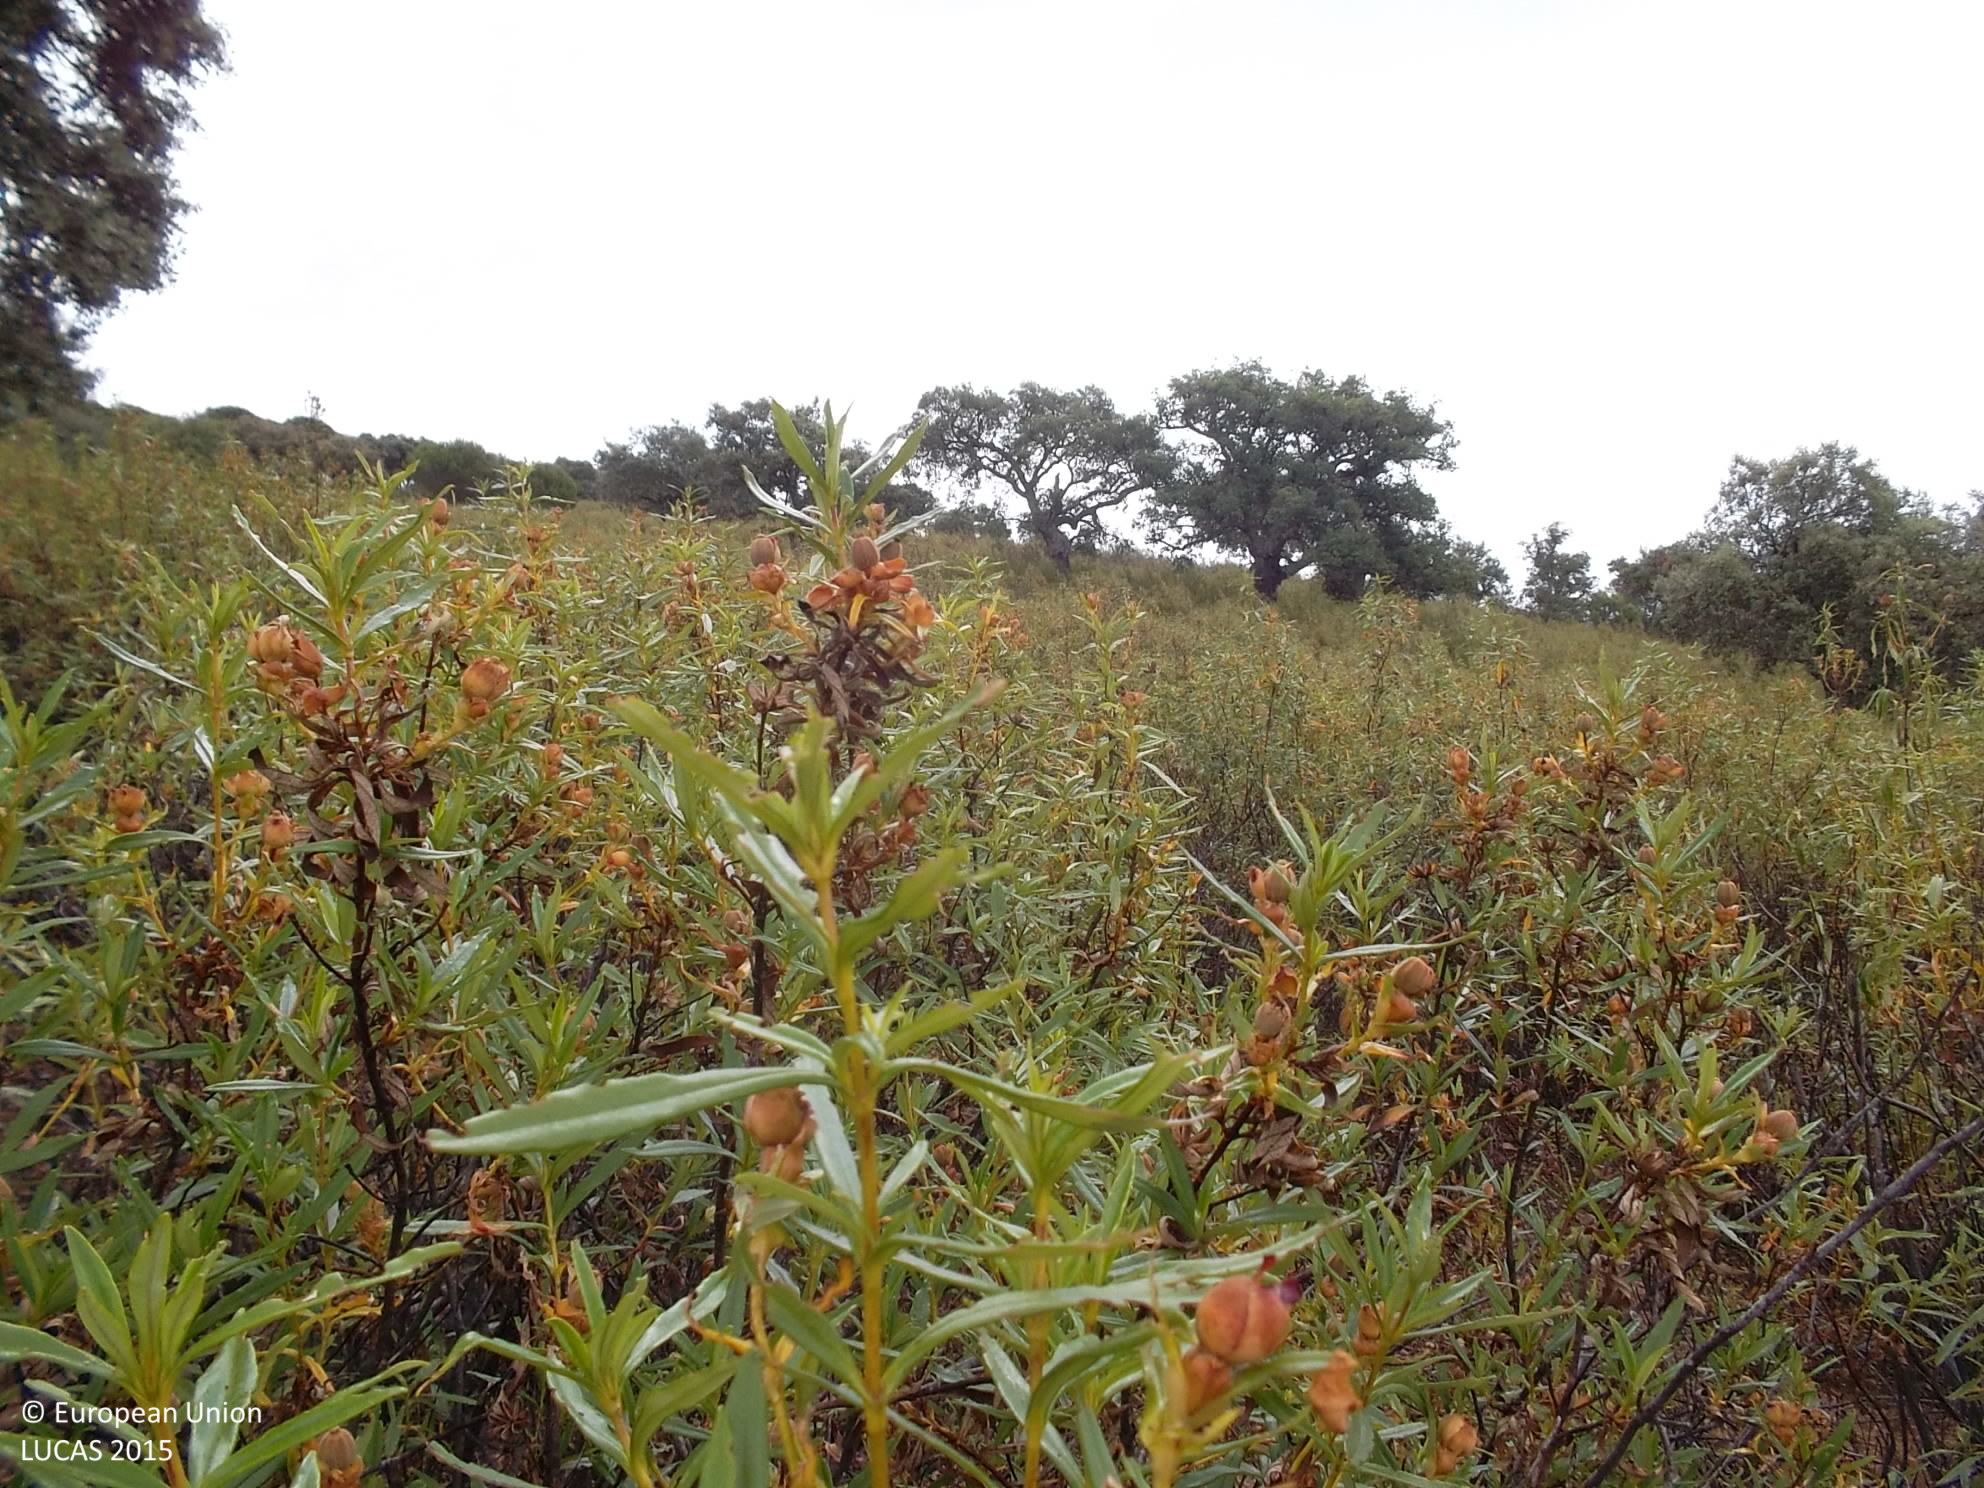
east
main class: Woodland
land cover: Broadleaved woodland
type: broadleaved evergreen forest
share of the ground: 50 - 75 %
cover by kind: shrubs 70 %, broadleaved forest trees 20 %, herbaceous plants 10 %
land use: Semi-natural and natural areas not in use
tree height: > 5 m
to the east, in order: Broadleaved woodland; Shrubland with sparse tree cover; Pine dominated mixed woodland; Tracks; Other structural elements; Pine dominated mixed woodland; Shrubland with sparse tree cover
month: June
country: ES
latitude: 39.3459
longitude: -4.9979
